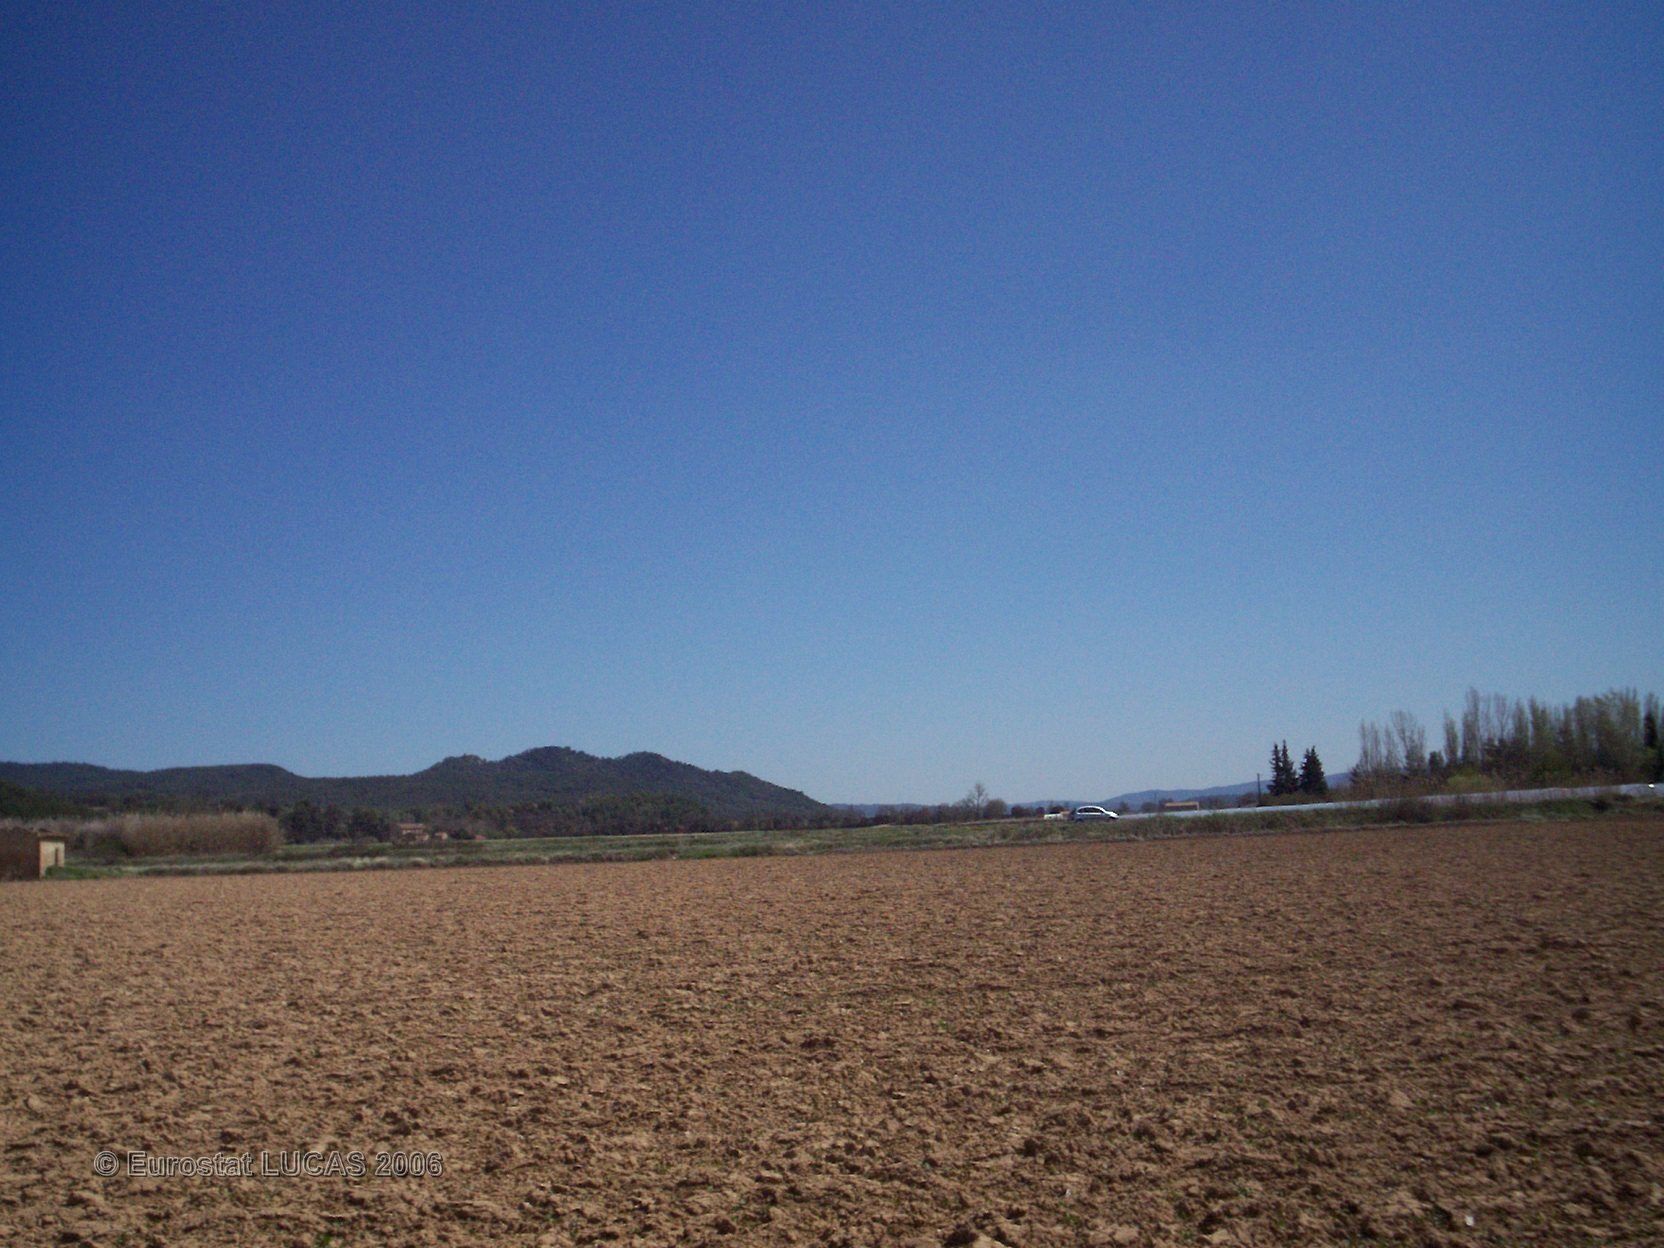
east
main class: Cropland
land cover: Maize
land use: Agriculture (excluding fallow land and kitchen gardens)
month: June
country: FR
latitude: 43.6762
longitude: 5.5315
